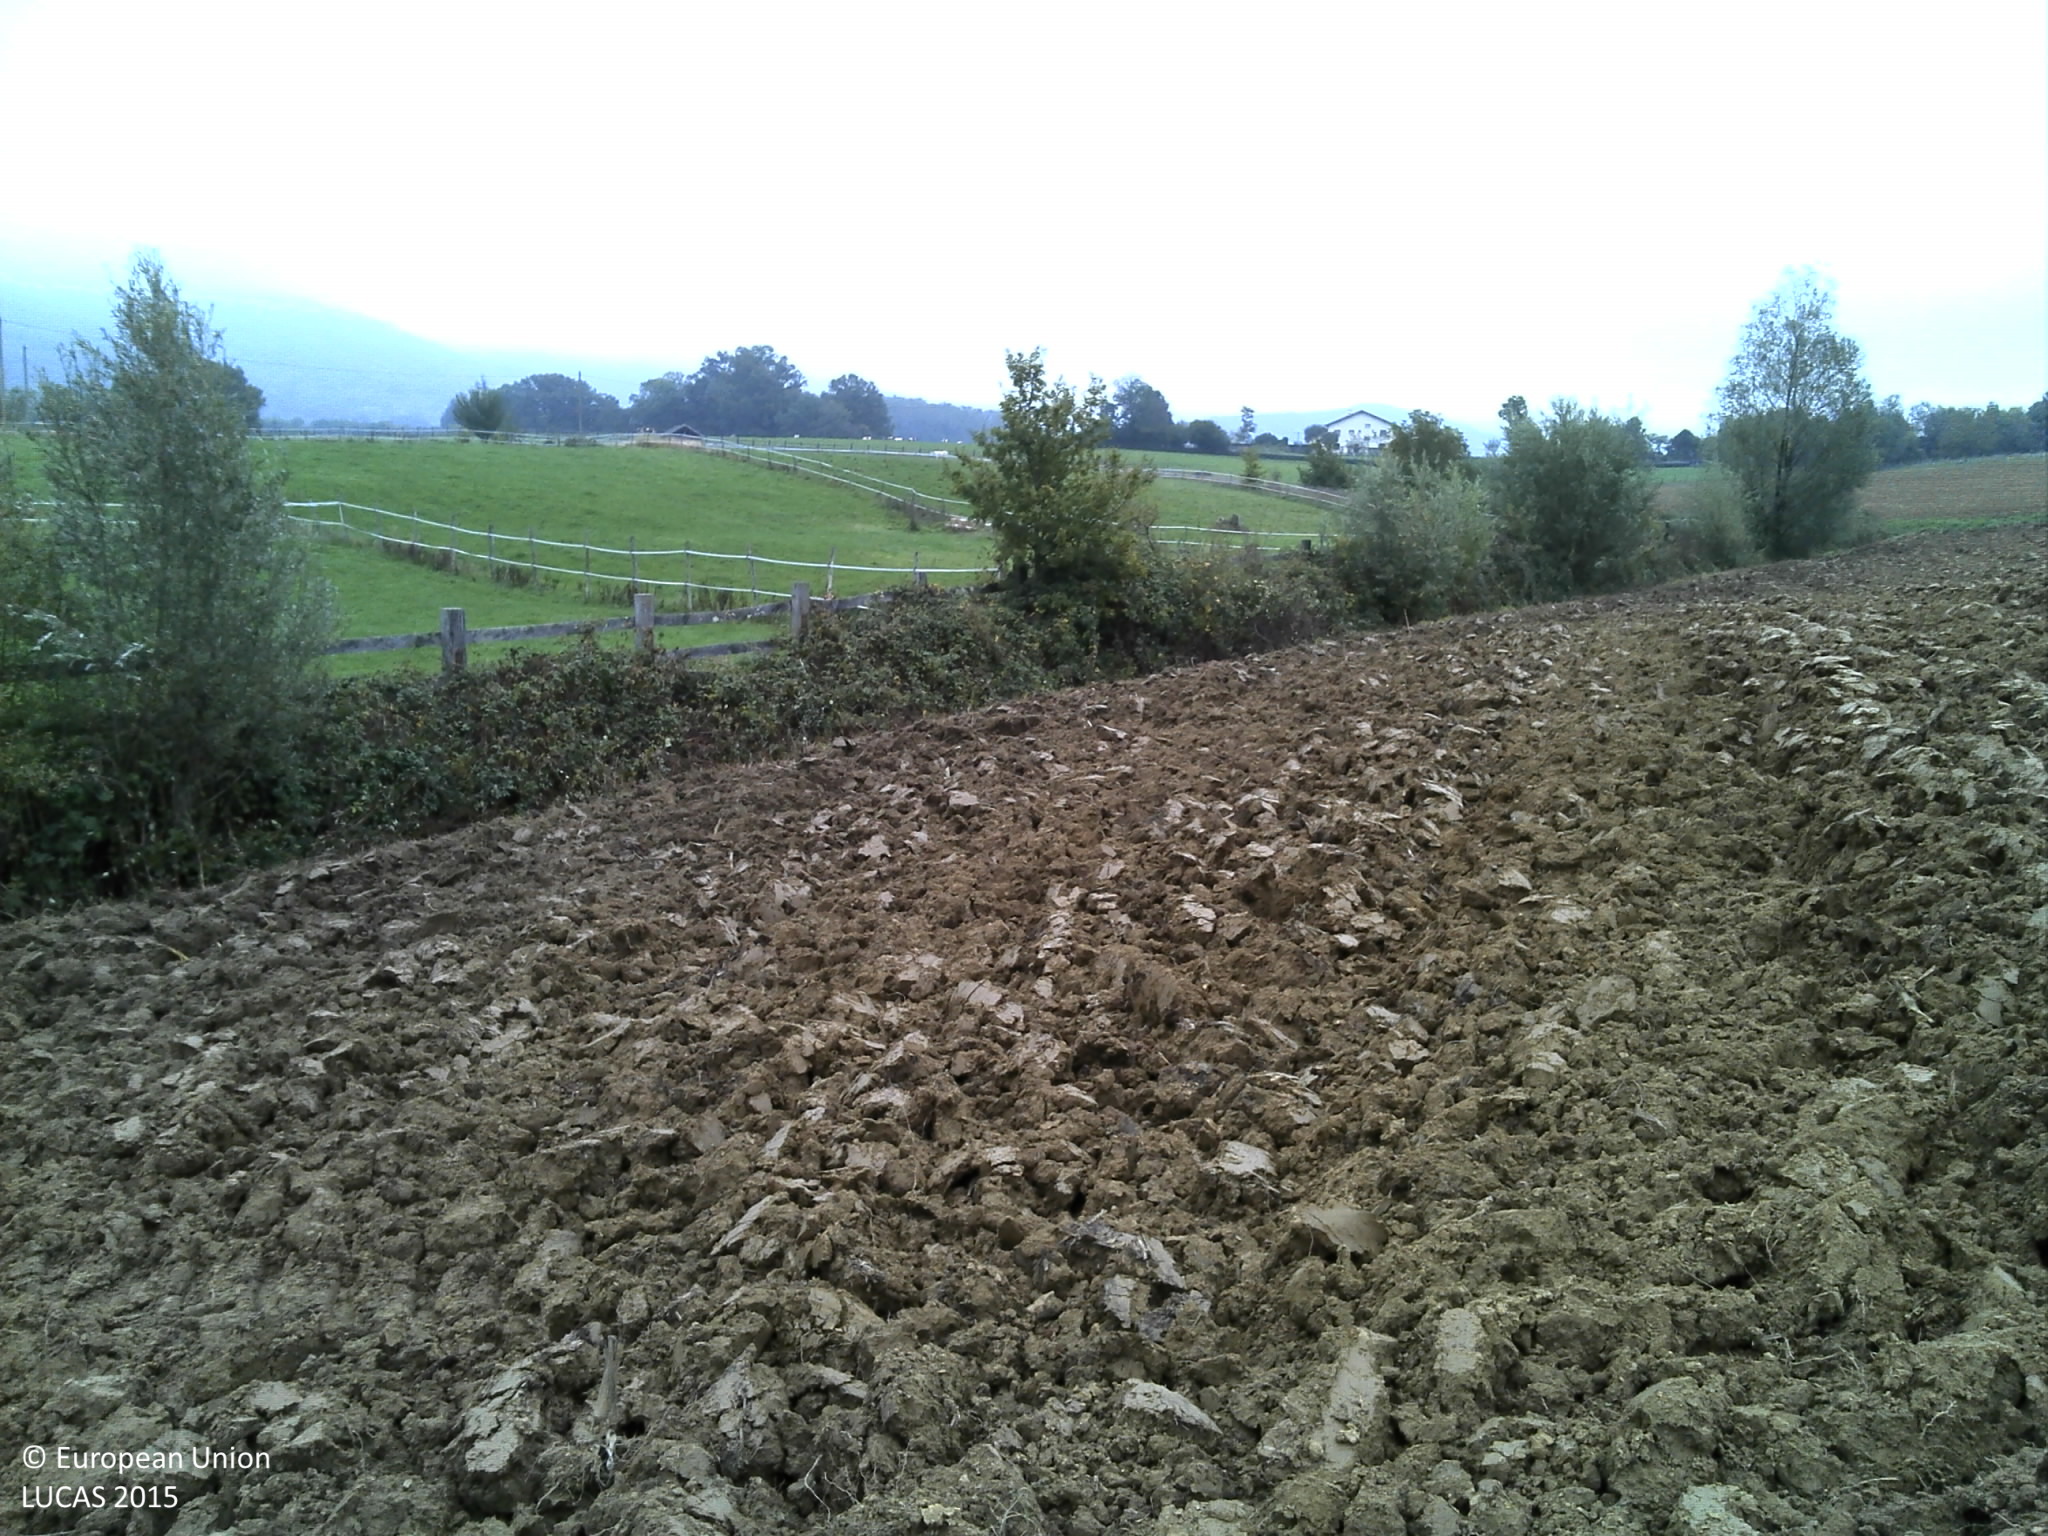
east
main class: Cropland
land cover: Maize
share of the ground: < 10 %
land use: Agriculture (excluding fallow land and kitchen gardens)
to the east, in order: Maize; Ditches and canals; Abandoned hedges; Fences; Grassland without tree/shrub cover; Fences; Grassland without tree/shrub cover; Fences; Grassland without tree/shrub cover; Electric lines; Fences; Tracks; Fences; Grassland without tree/shrub cover
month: October
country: FR
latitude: 46.3398
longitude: 5.3386
